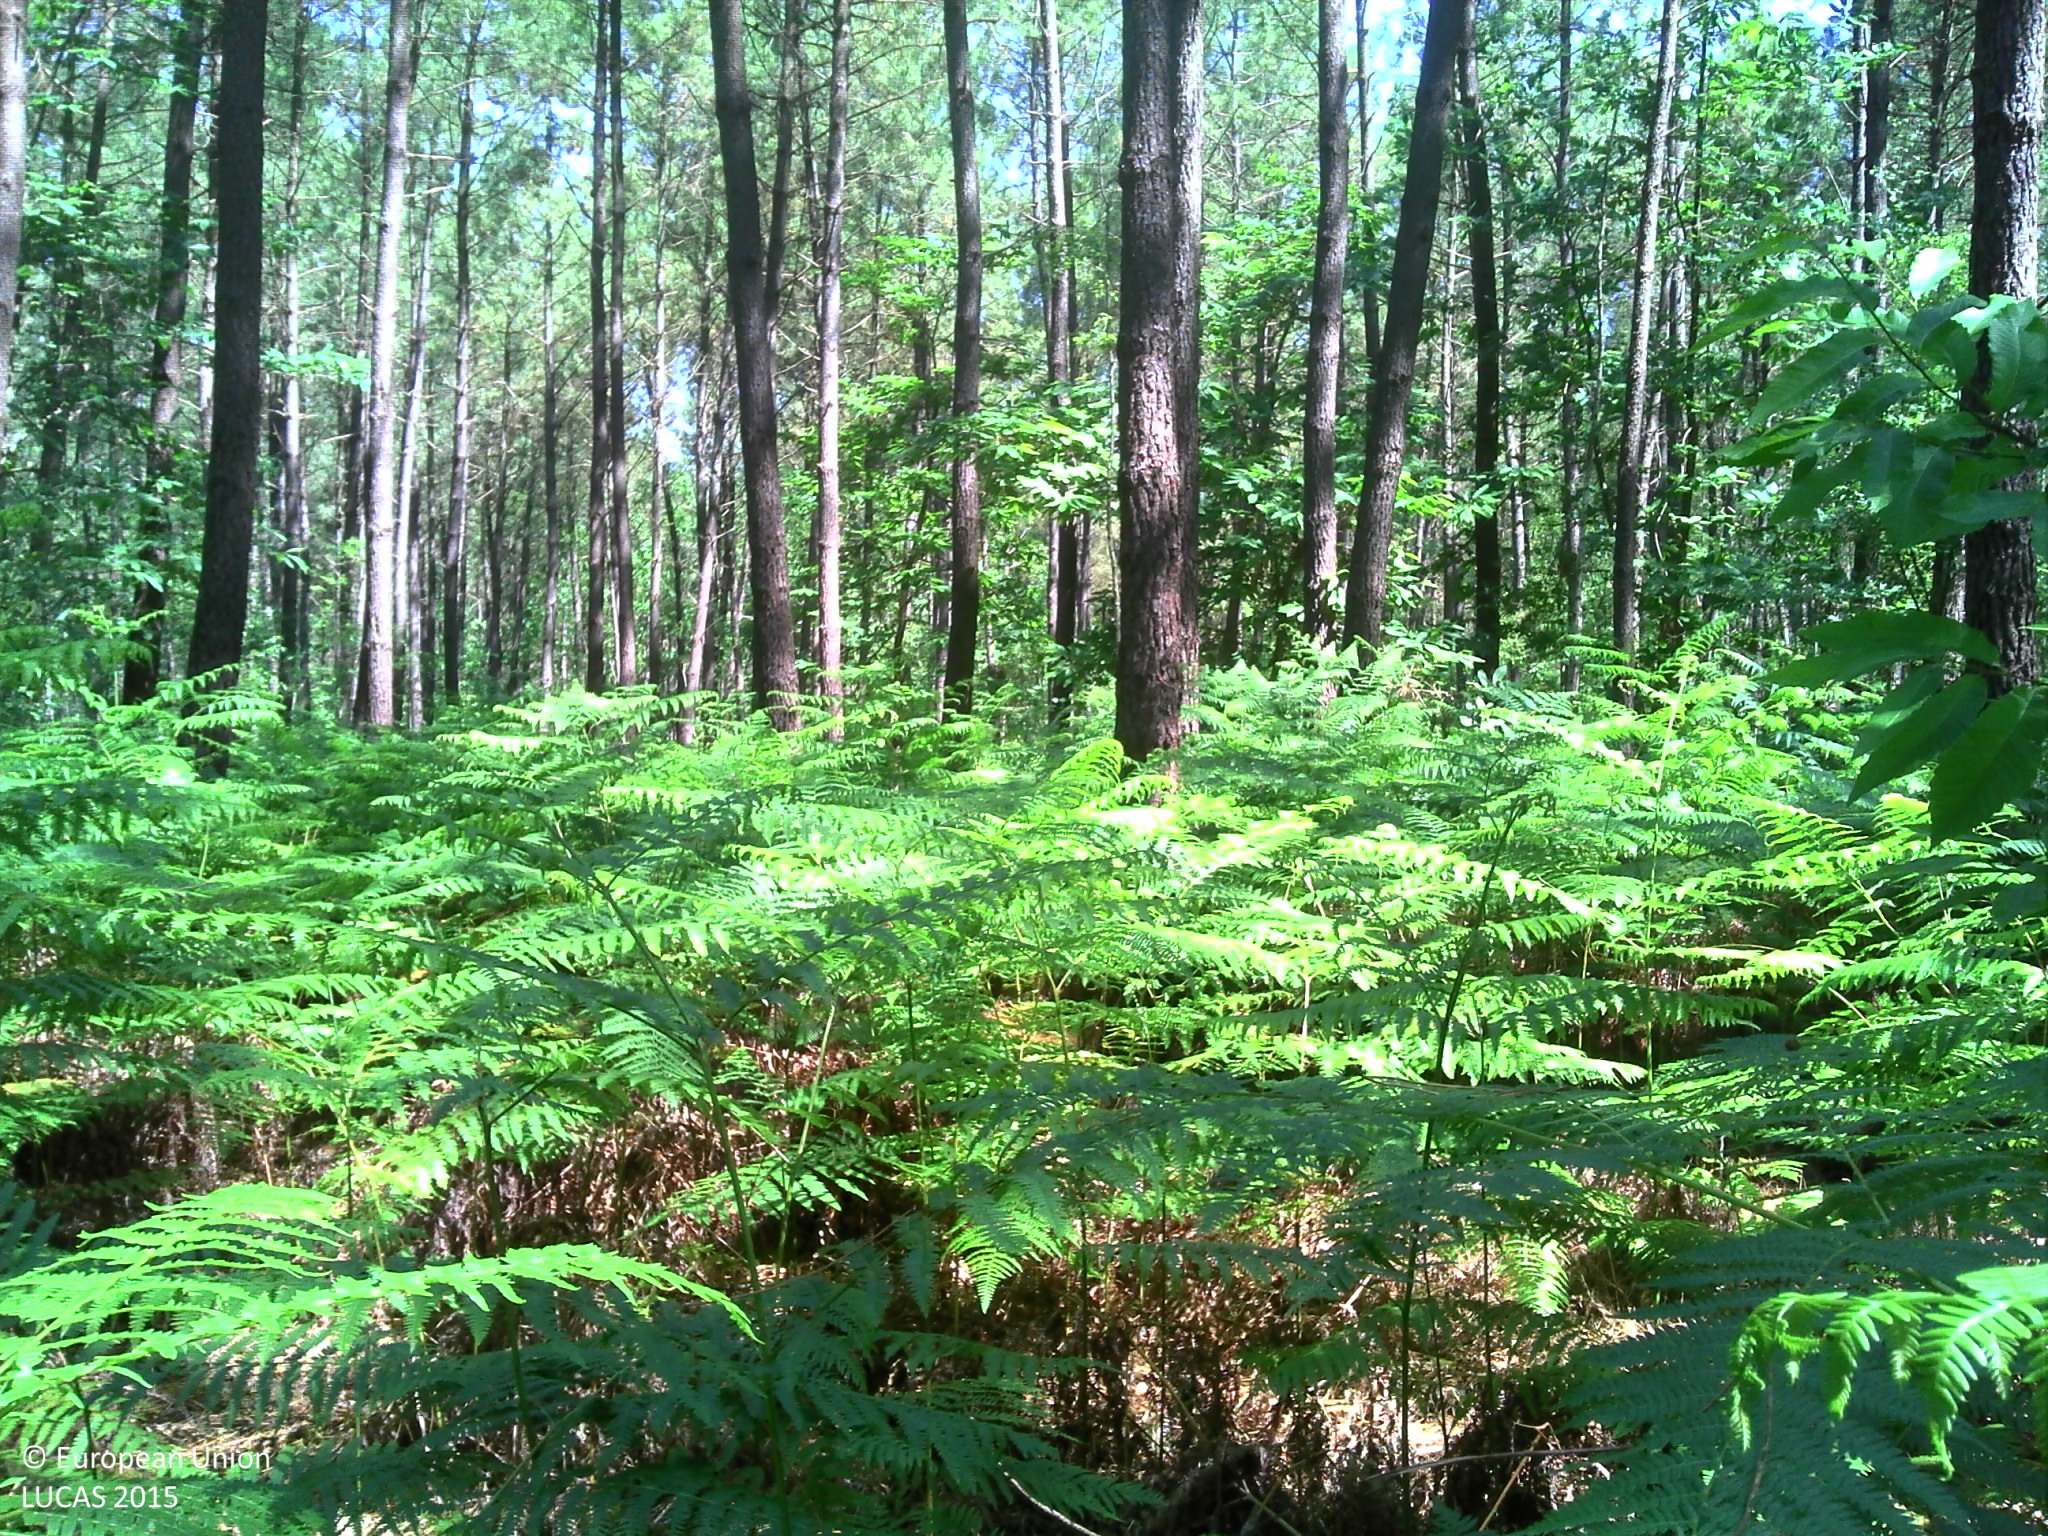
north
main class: Woodland
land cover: Pine dominated mixed woodland
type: hemiboreal forest and nemoral coniferous forest and mixed broadleaved-coniferous forest
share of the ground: > 75 %
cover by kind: coniferous forest trees 55 %, broadleaved forest trees 20 %, herbaceous plants 15 %, lichens and mosses 10 %
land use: Forestry
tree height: > 5 m
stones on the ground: < 10 %
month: June
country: FR
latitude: 47.3740
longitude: 0.0556
